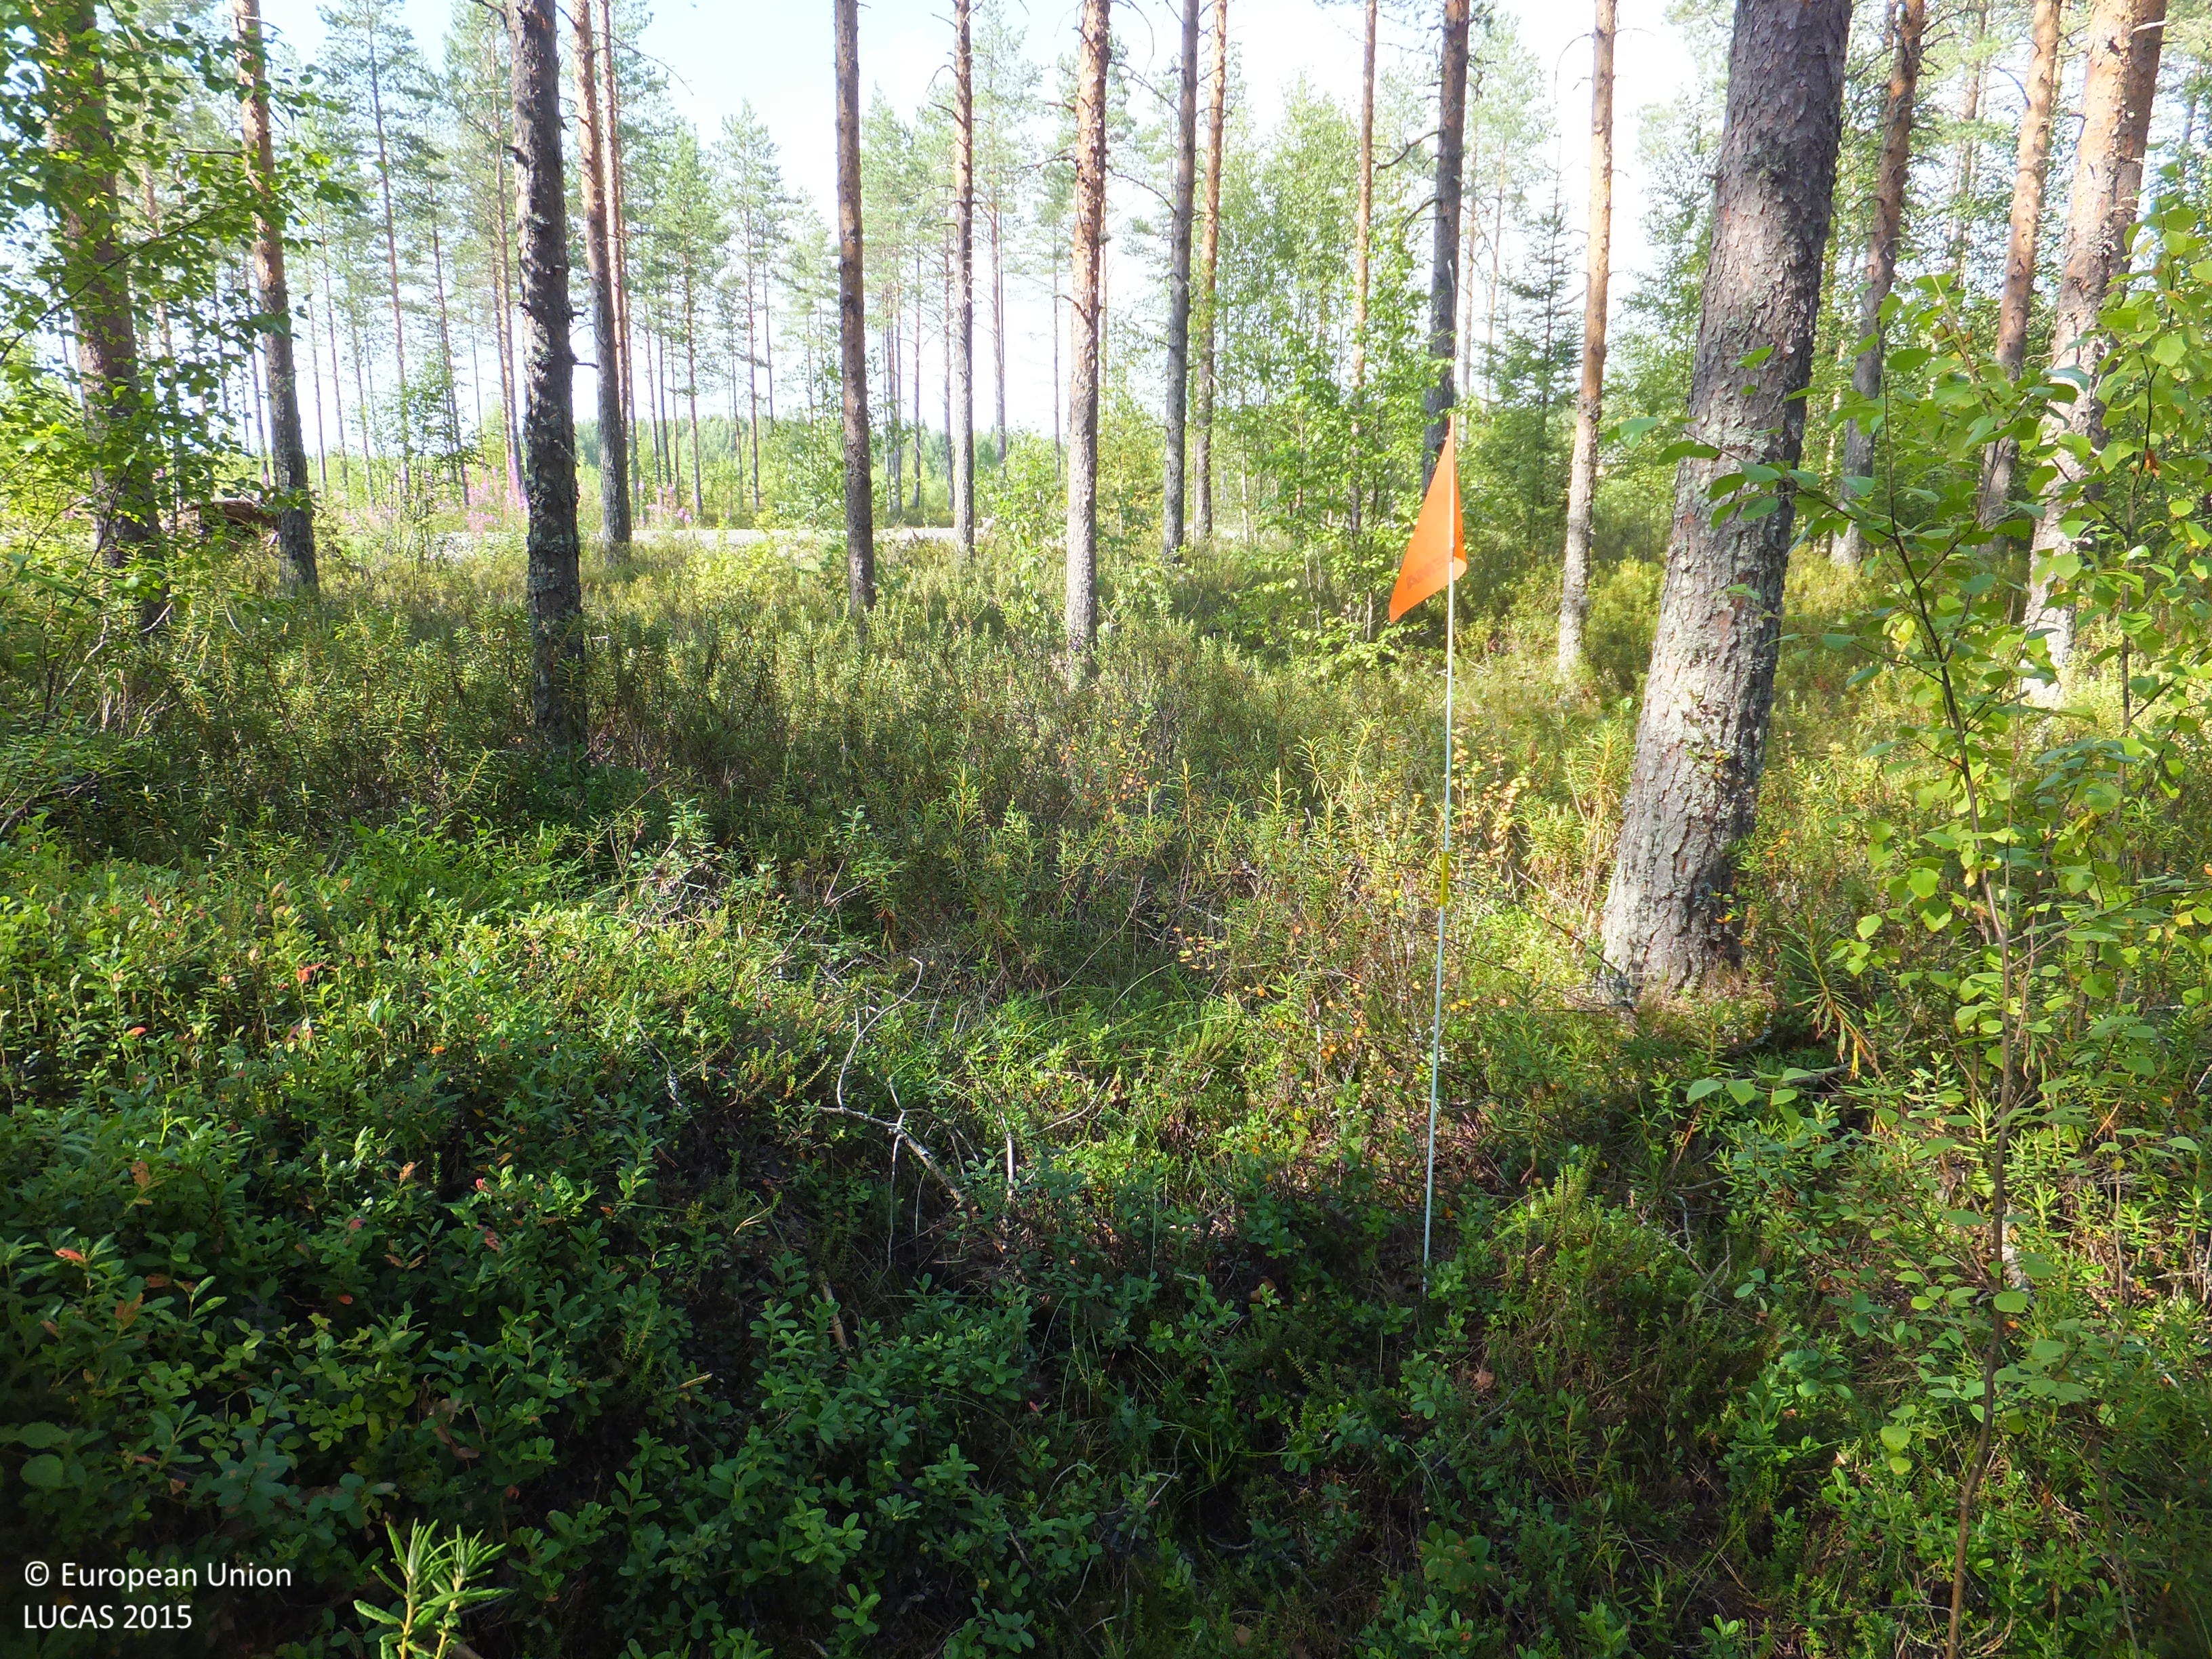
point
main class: Woodland
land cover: Pine dominated coniferous woodland
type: boreal forest
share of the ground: > 75 %
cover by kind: coniferous forest trees 70 %, broadleaved forest trees 10 %, shrubs 10 %, herbaceous plants 5 %, lichens and mosses 5 %
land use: Forestry
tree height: > 5 m
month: August
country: FI
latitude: 63.2058
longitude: 22.7187
